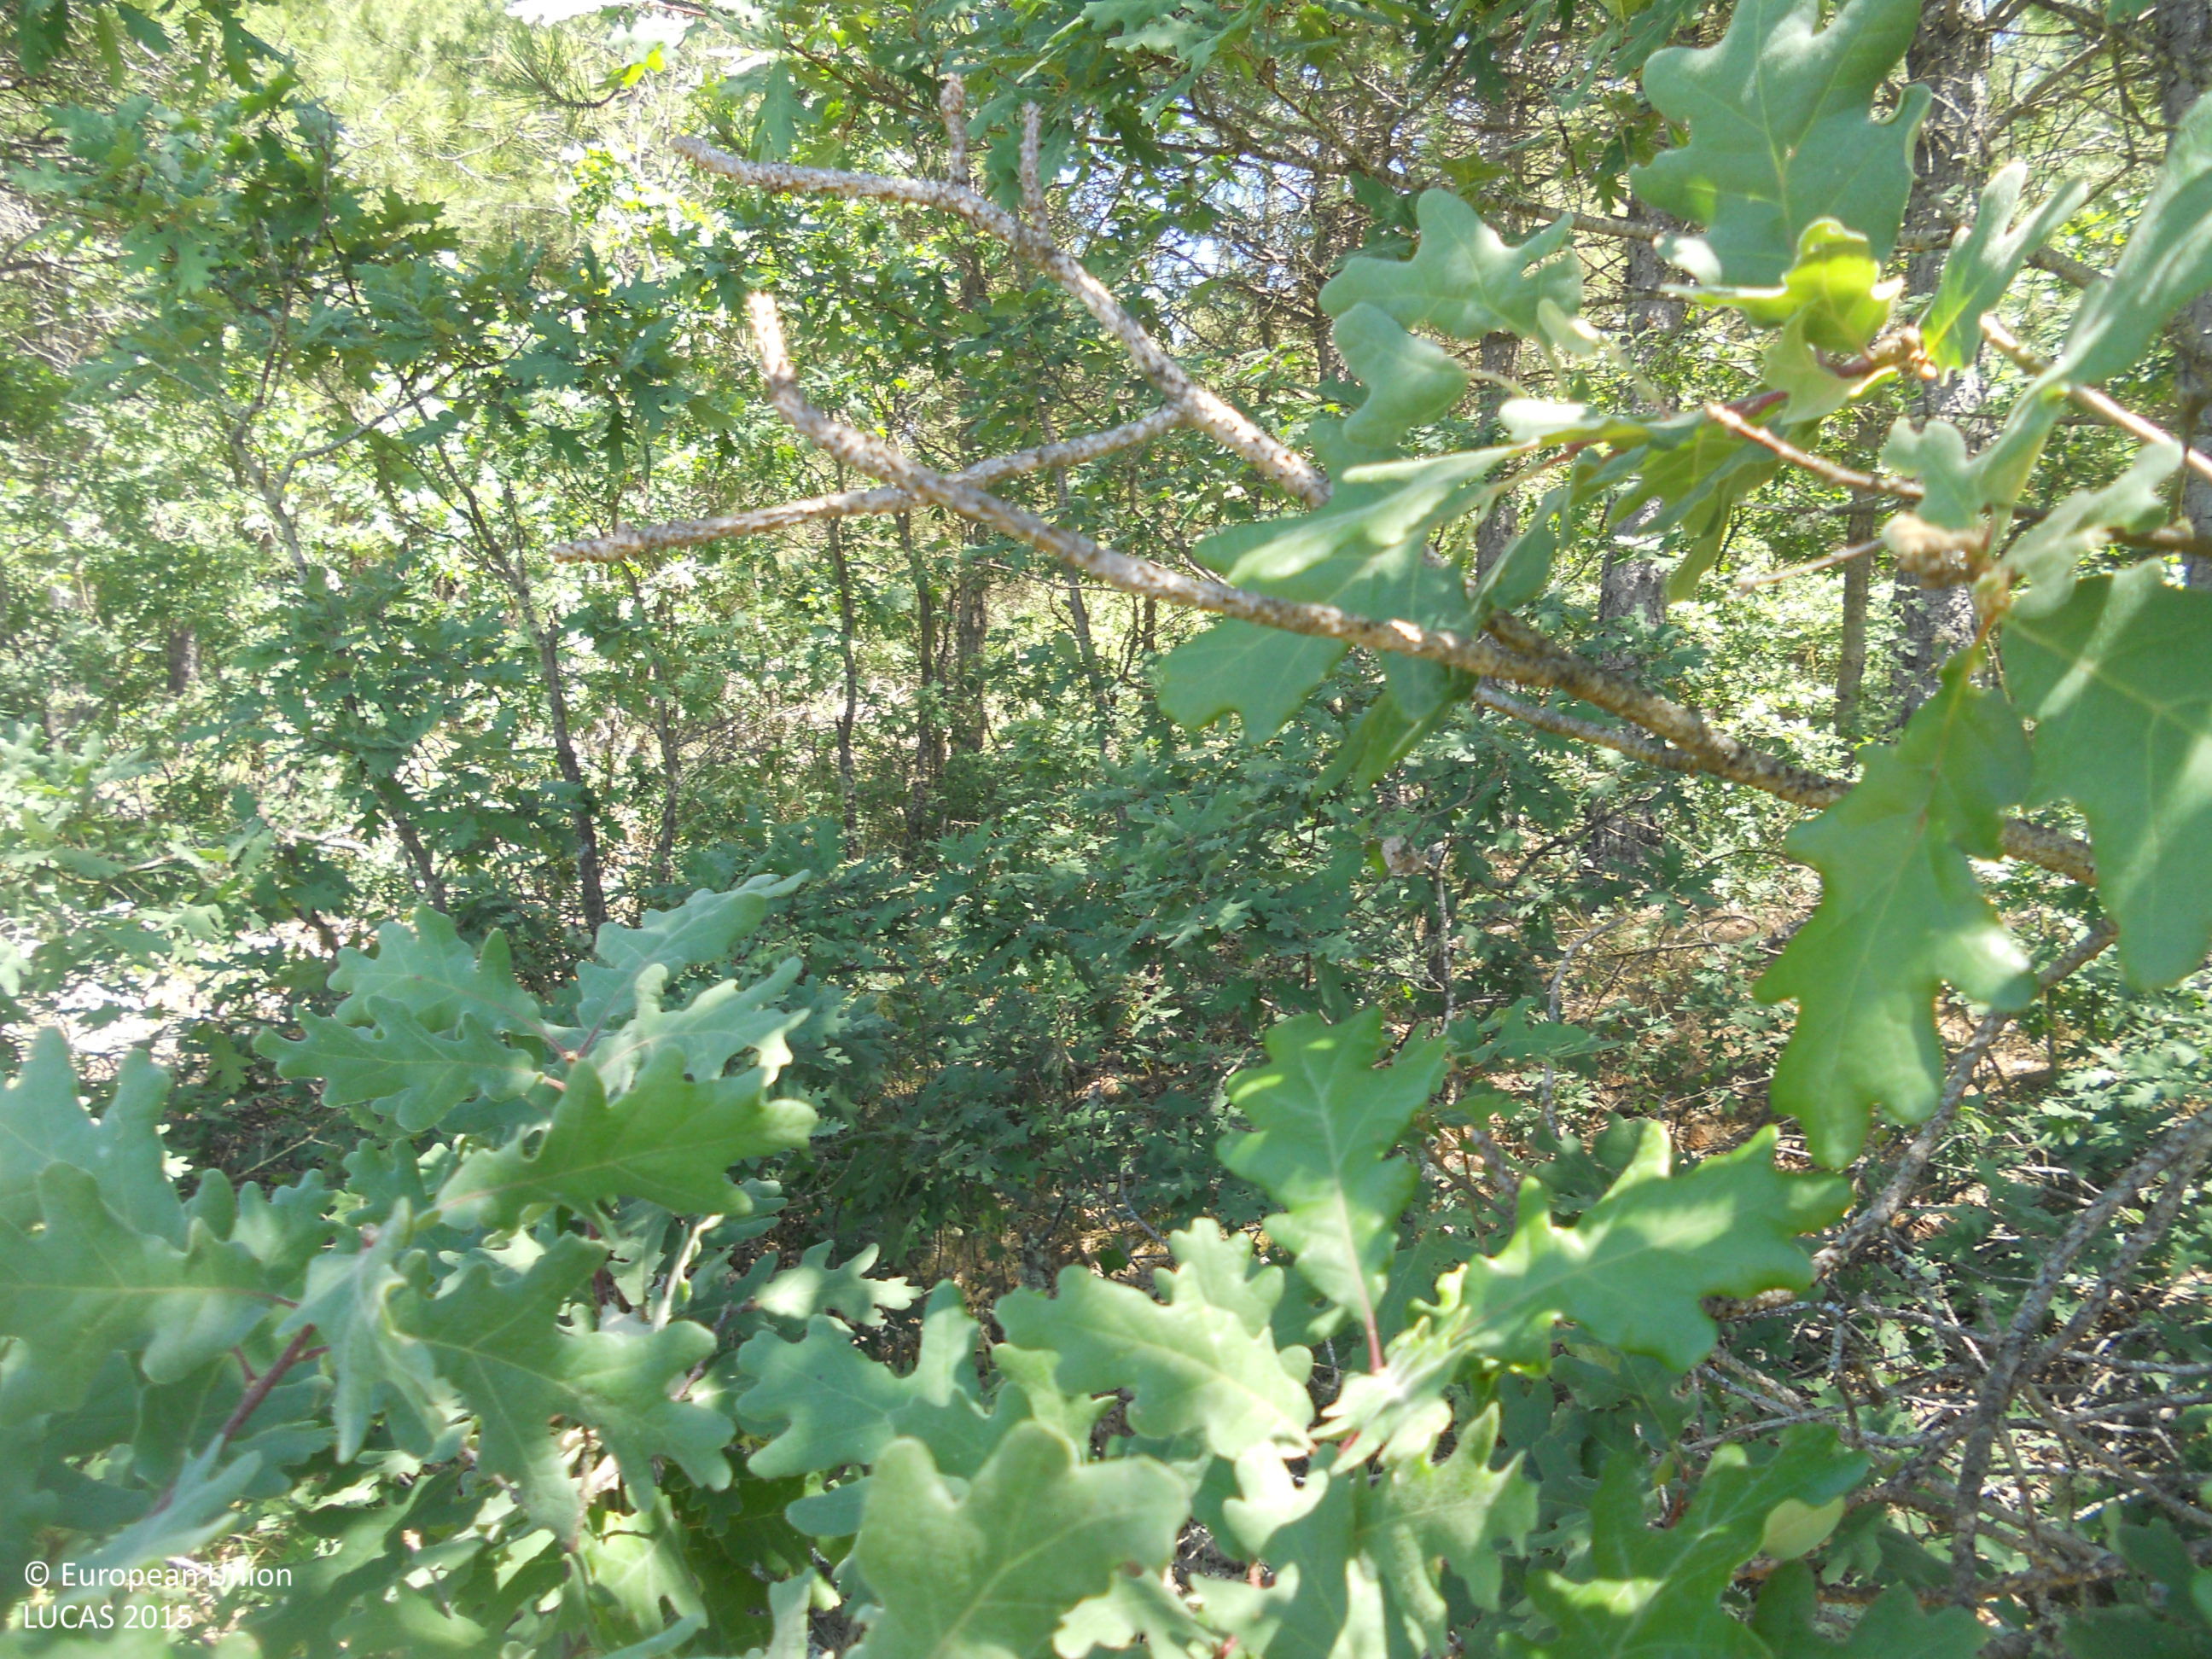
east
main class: Woodland
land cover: Pine dominated coniferous woodland
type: coniferous forest of the mediterranean region
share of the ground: > 75 %
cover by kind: coniferous forest trees 60 %, broadleaved forest trees 20 %, shrubs 10 %, herbaceous plants 10 %
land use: Forestry
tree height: > 5 m
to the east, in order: Pine dominated coniferous woodland
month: June
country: ES
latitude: 42.4676
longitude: -4.8586
